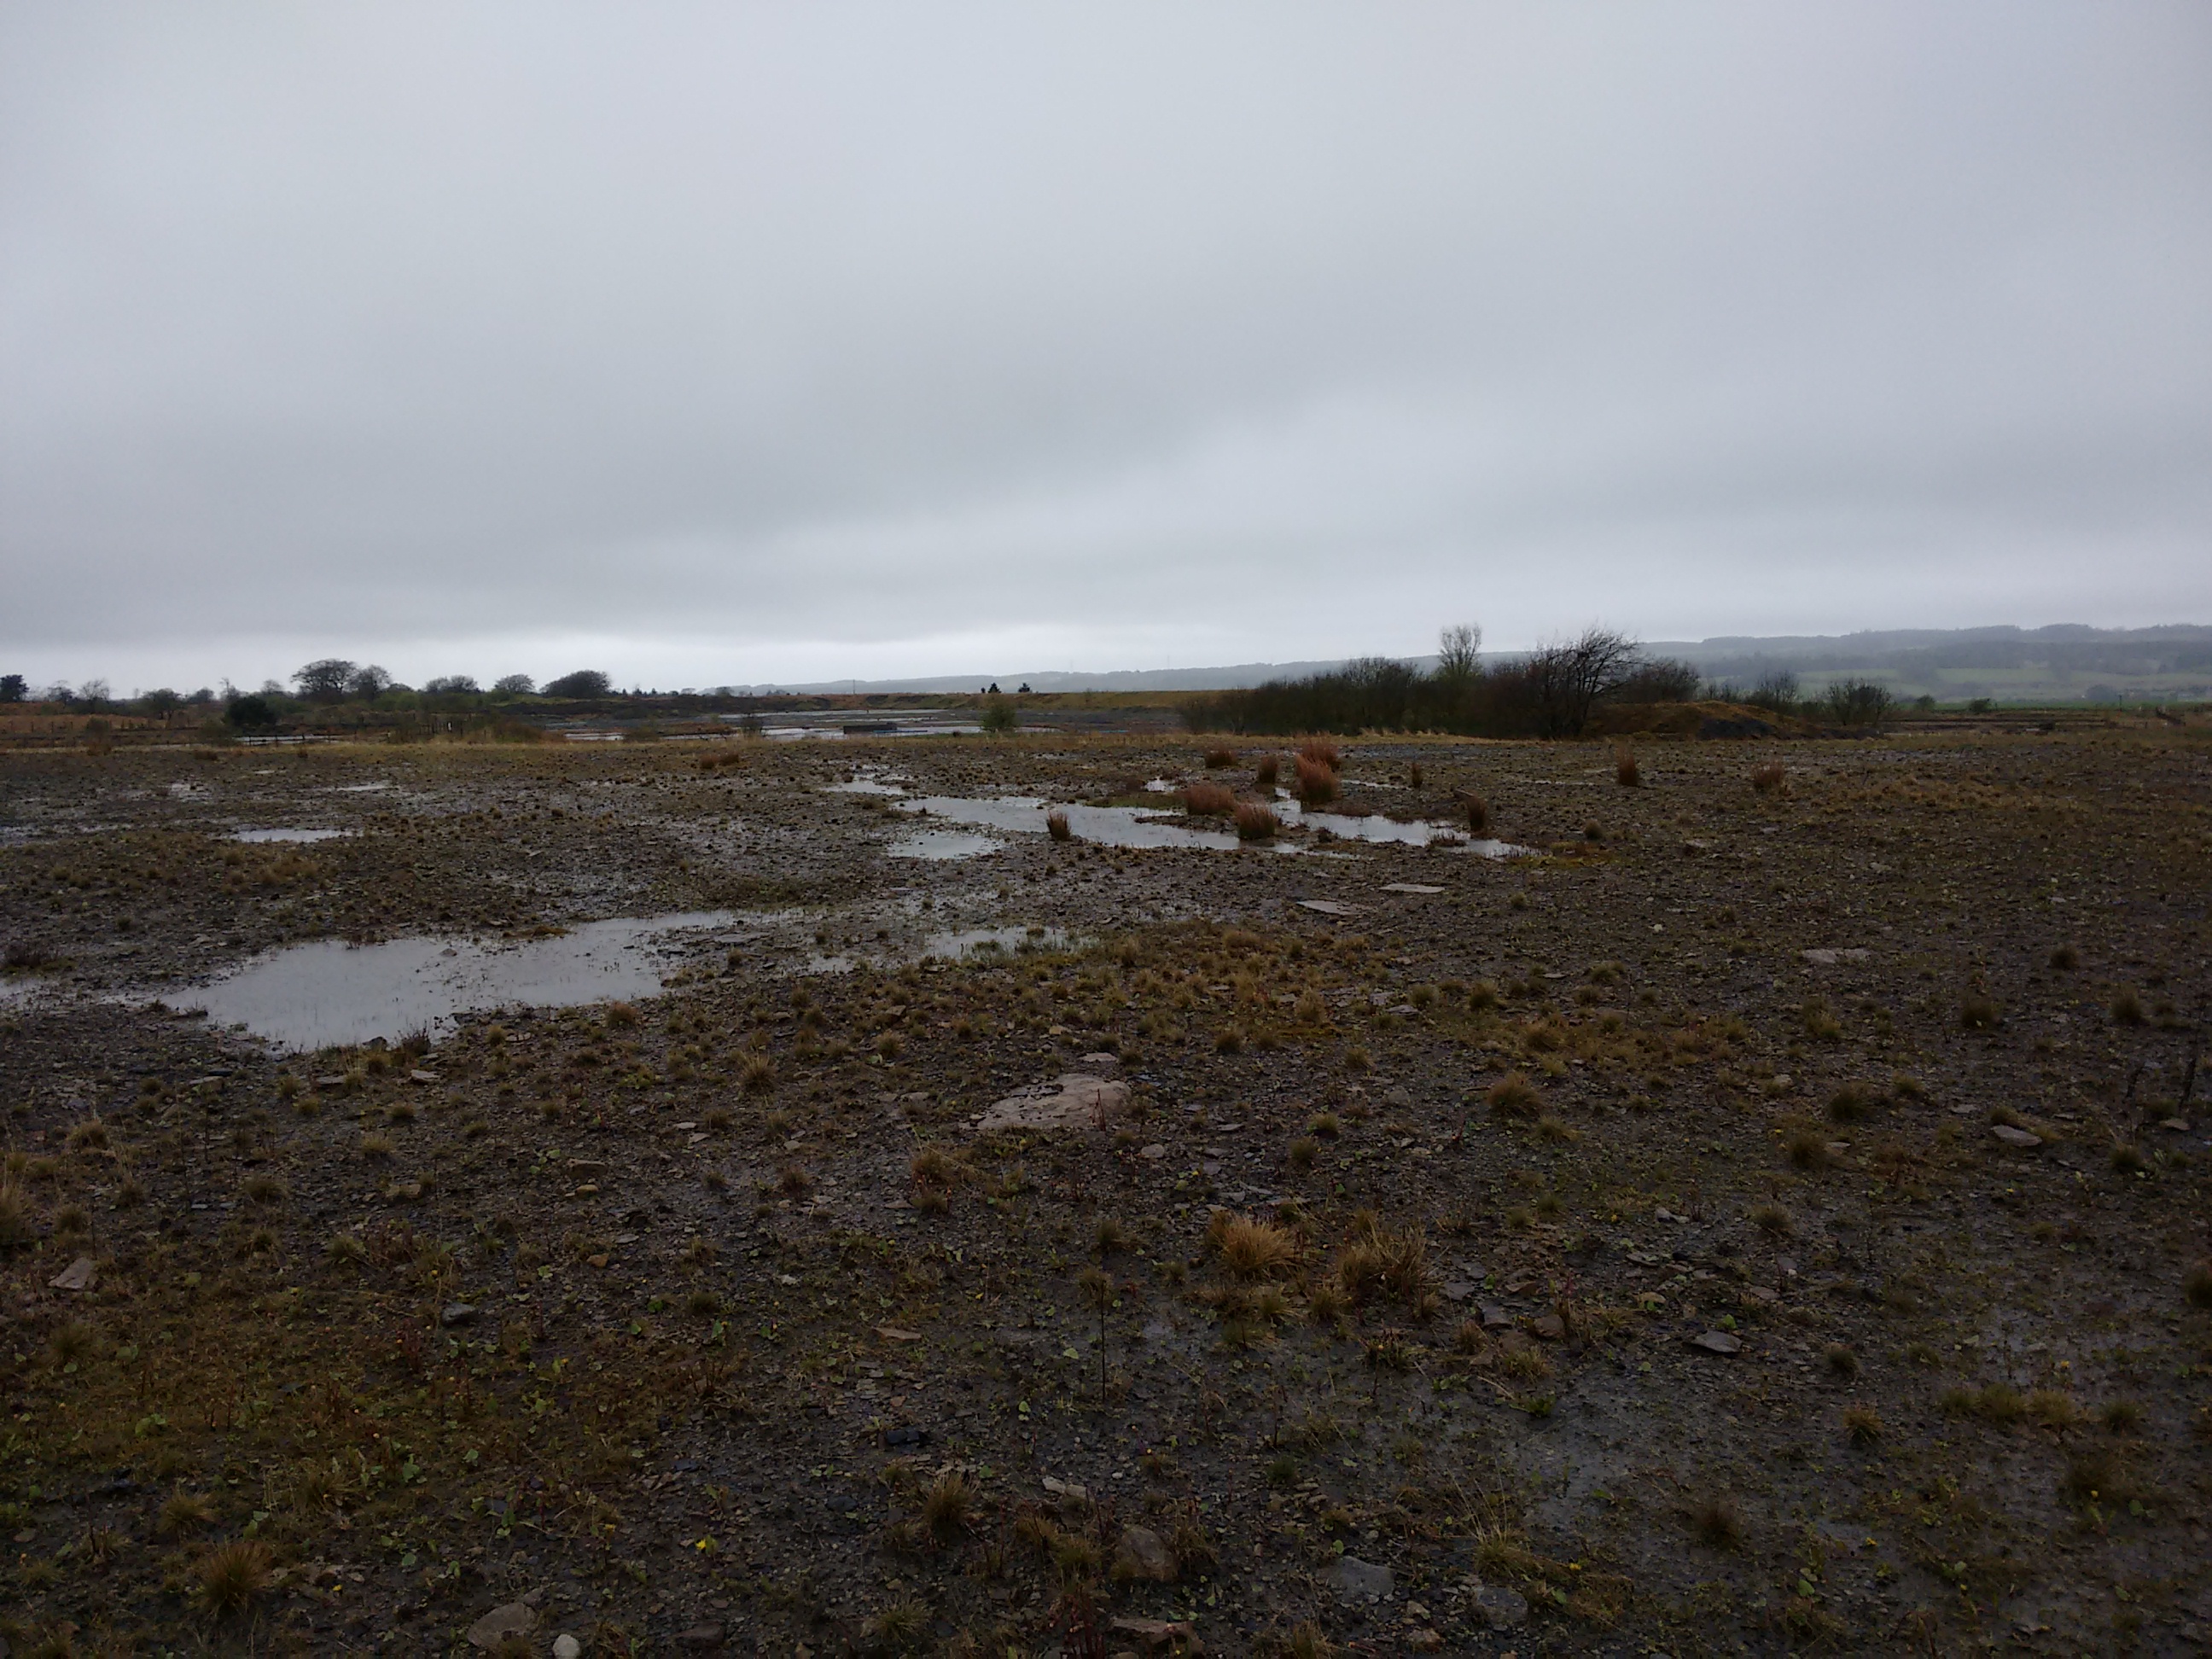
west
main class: Grassland
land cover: Spontaneously vegetated surfaces
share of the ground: > 75 %
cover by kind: herbaceous plants 50 %, unconsolidated bare surface 50 %
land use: Abandoned areas
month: May
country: GB
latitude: 55.8040
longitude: -3.7881
